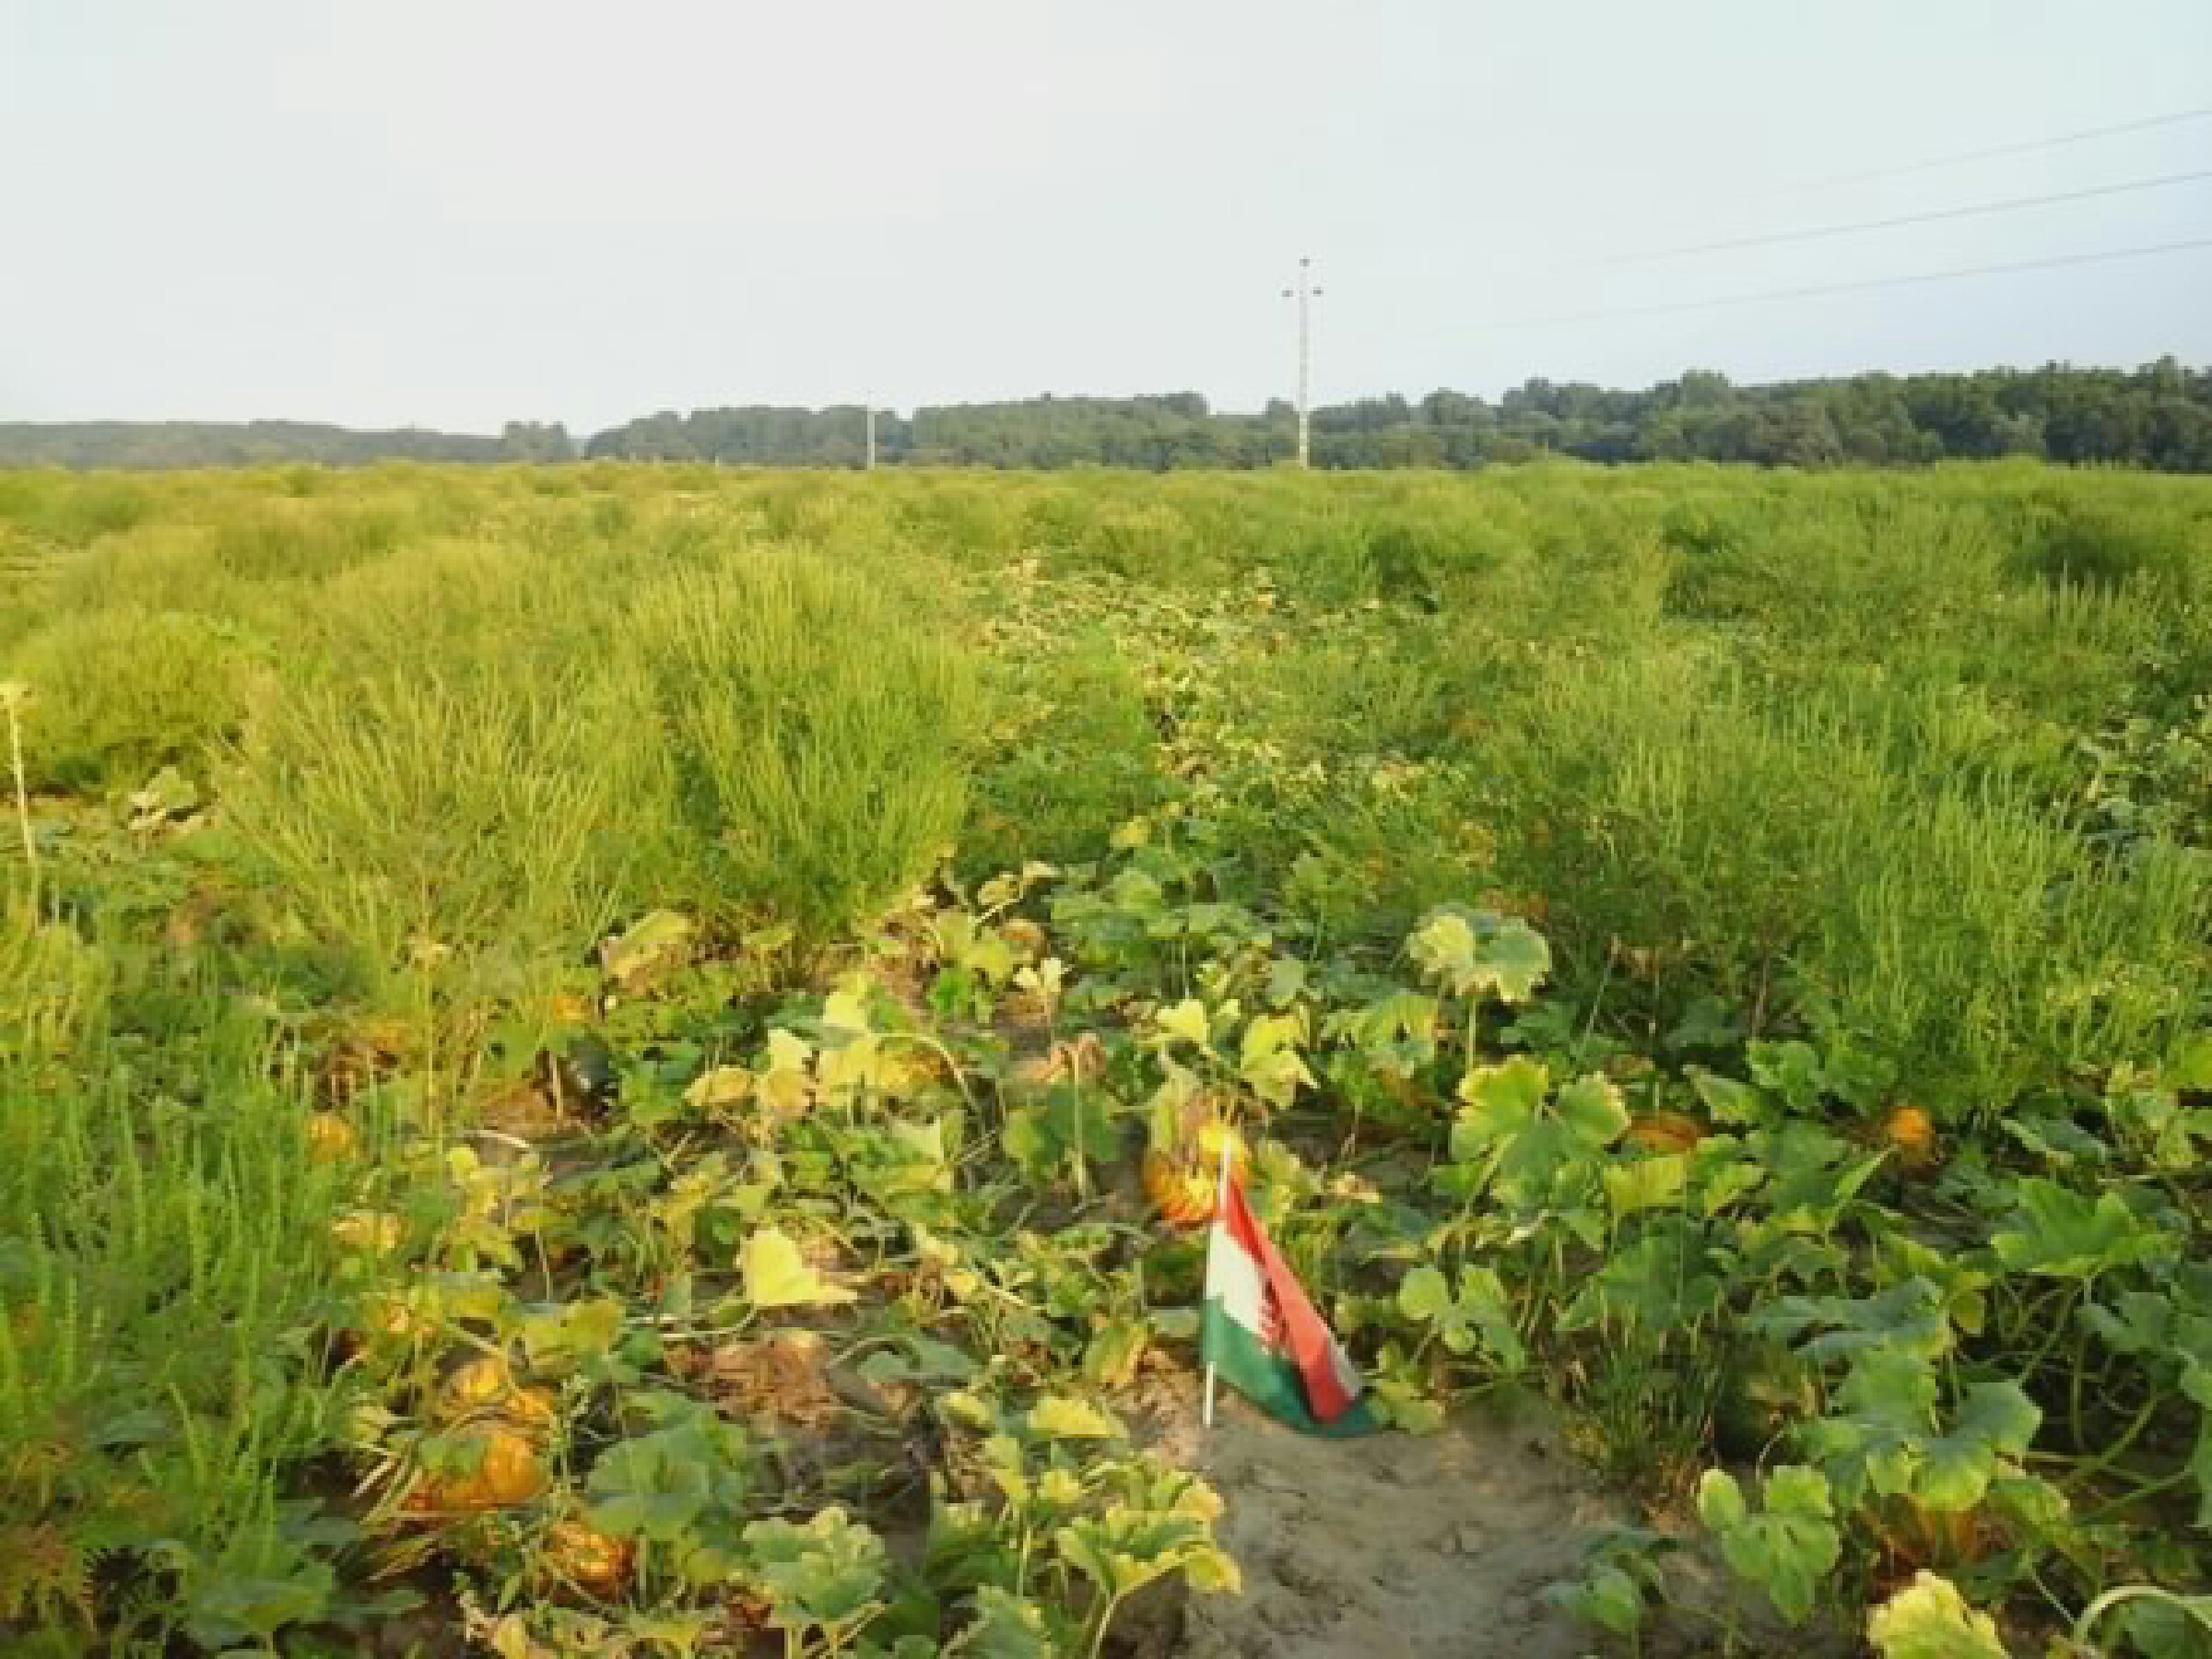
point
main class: Cropland
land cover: Other fresh vegetables
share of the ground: 25 - 50 %
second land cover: Spontaneously vegetated surfaces
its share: 25 - 50 %
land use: Agriculture (excluding fallow land and kitchen gardens)
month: August
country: HU
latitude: 48.0789
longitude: 19.3513
